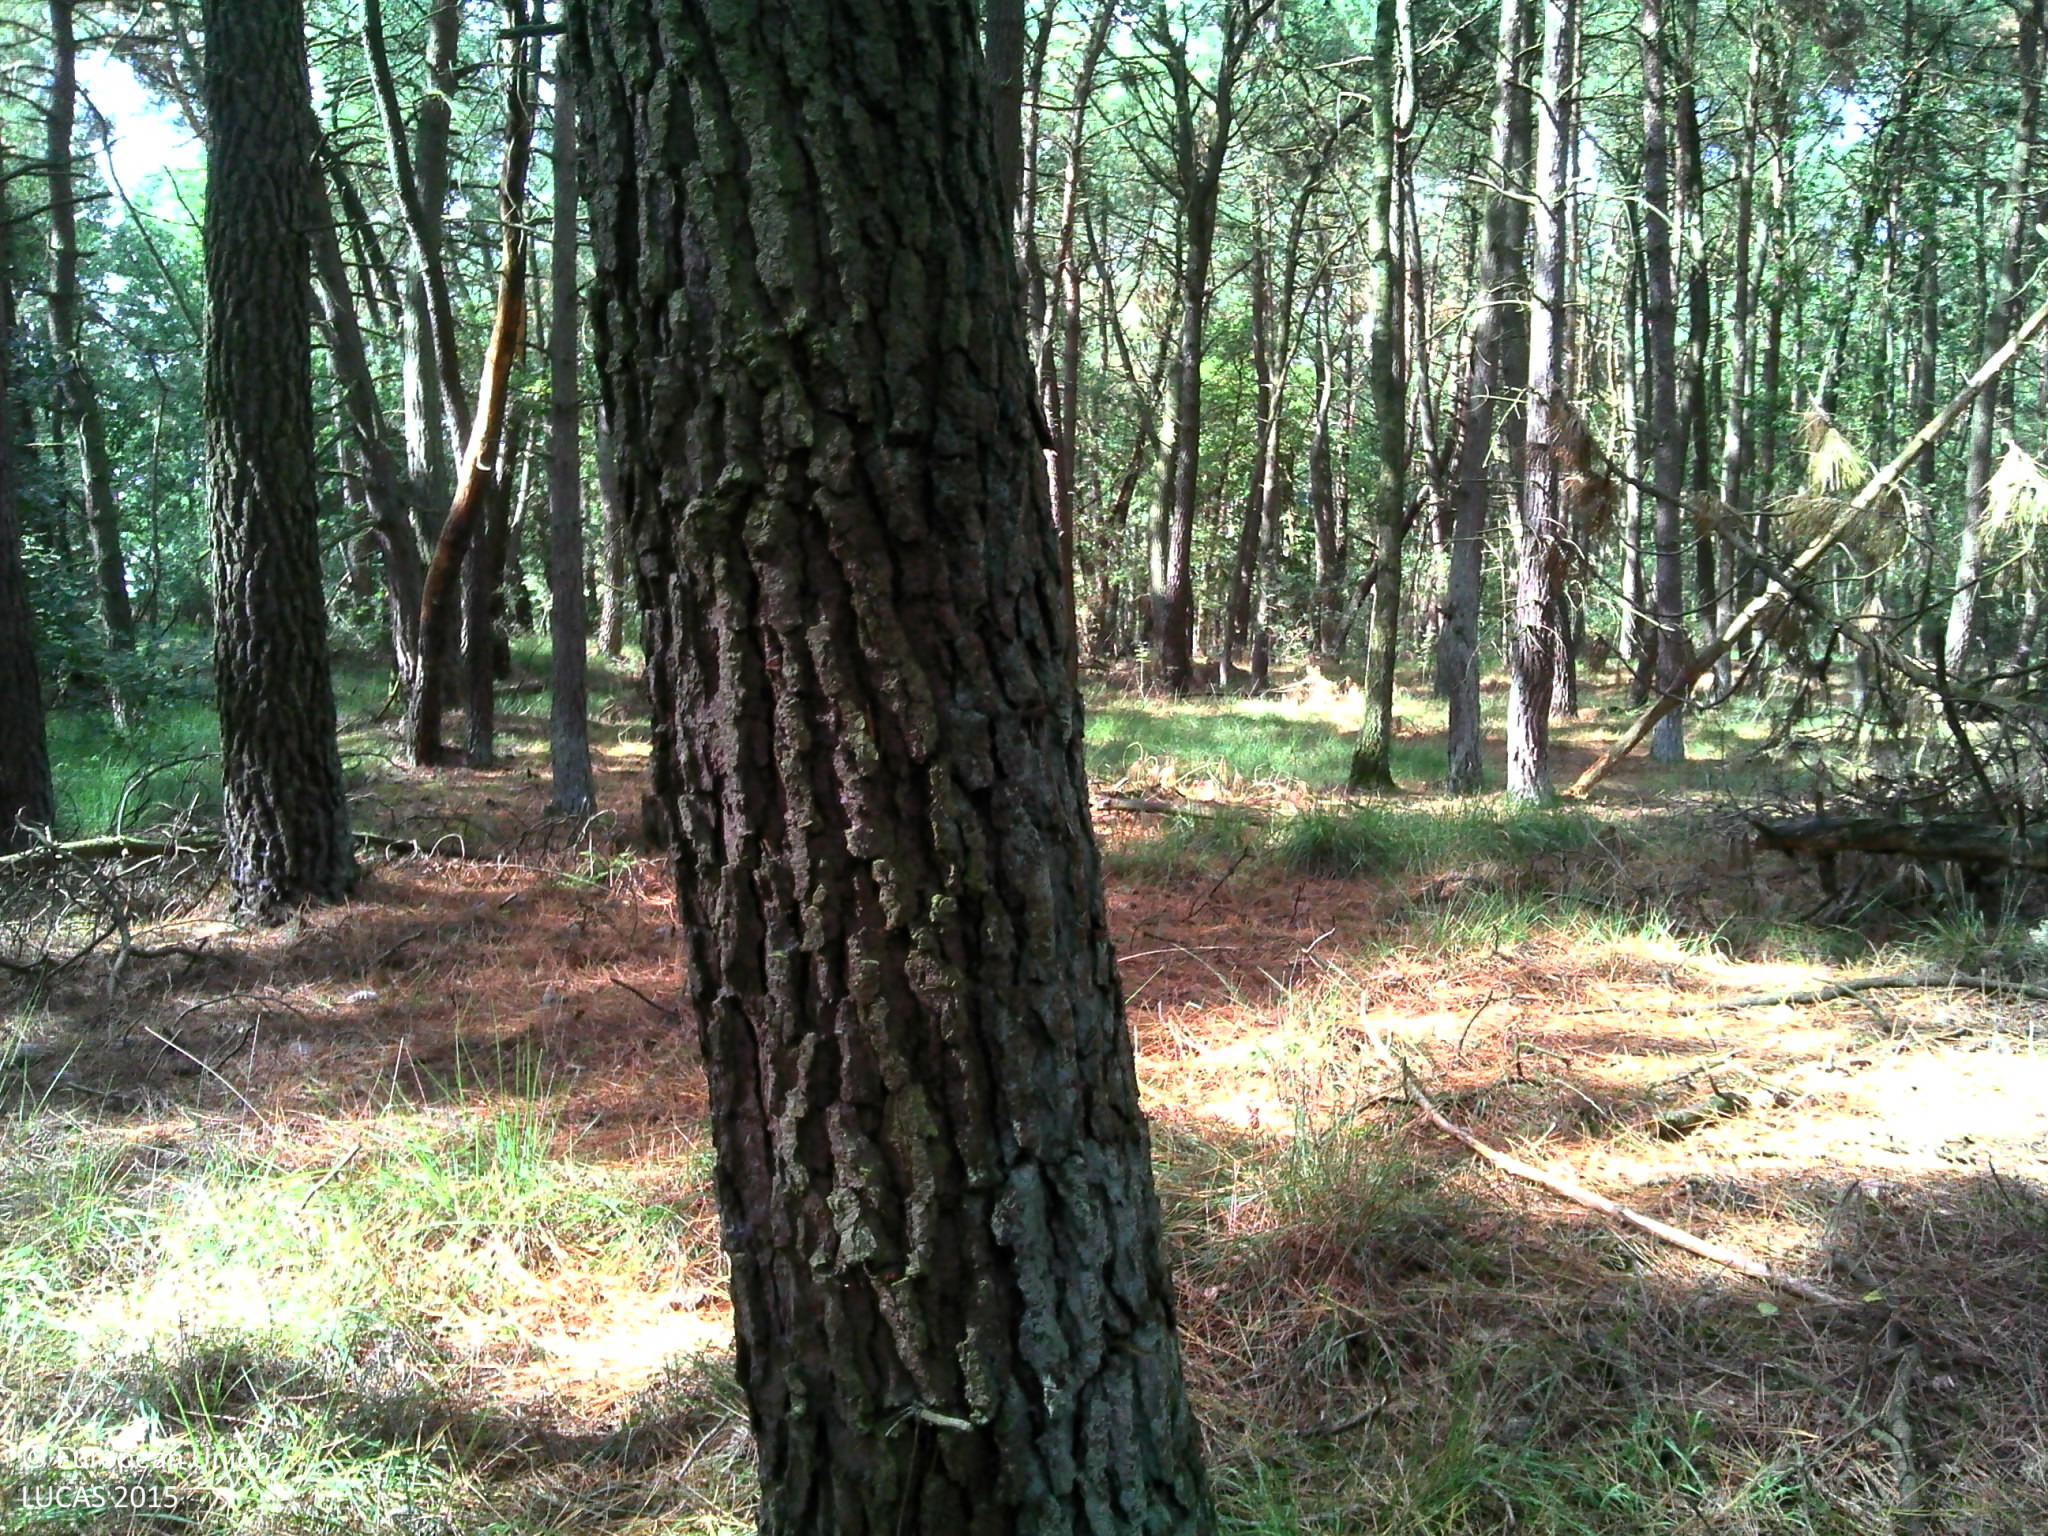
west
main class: Woodland
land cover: Pine dominated coniferous woodland
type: exotic forest
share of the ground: > 75 %
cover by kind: coniferous forest trees 90 %, broadleaved forest trees 5 %, herbaceous plants 5 %
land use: Forestry
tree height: > 5 m
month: September
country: BE
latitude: 51.4165
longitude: 4.4020
